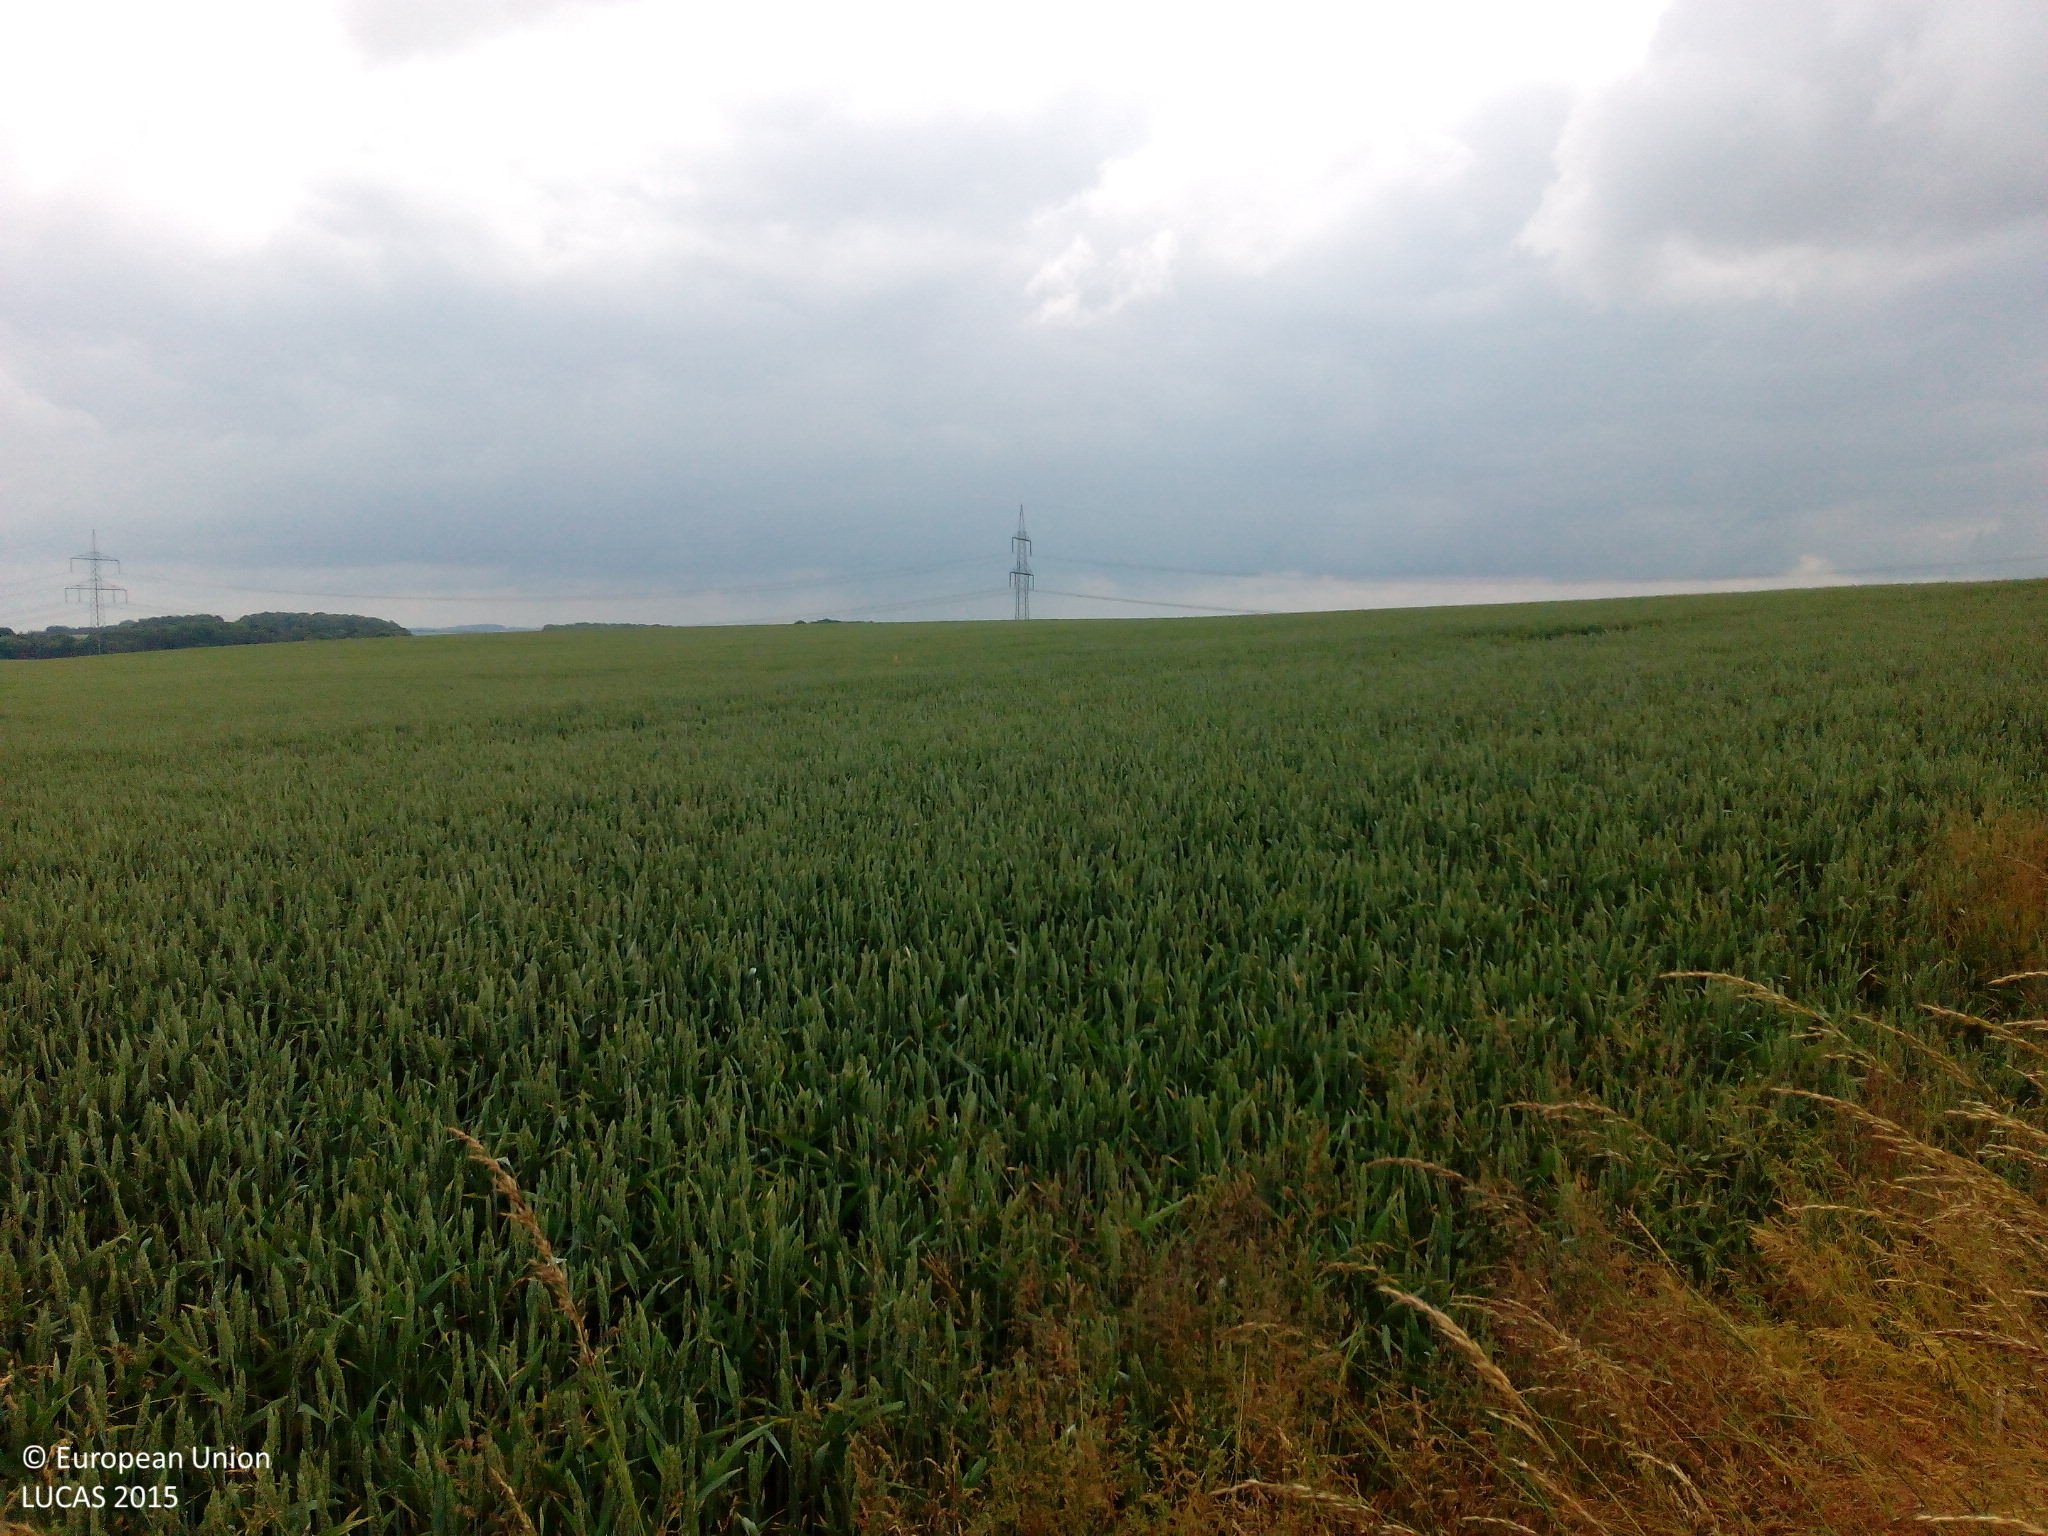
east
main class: Cropland
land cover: Common wheat
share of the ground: > 75 %
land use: Agriculture (excluding fallow land and kitchen gardens)
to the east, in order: Common wheat
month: June
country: DE
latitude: 51.0419
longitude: 13.0951
